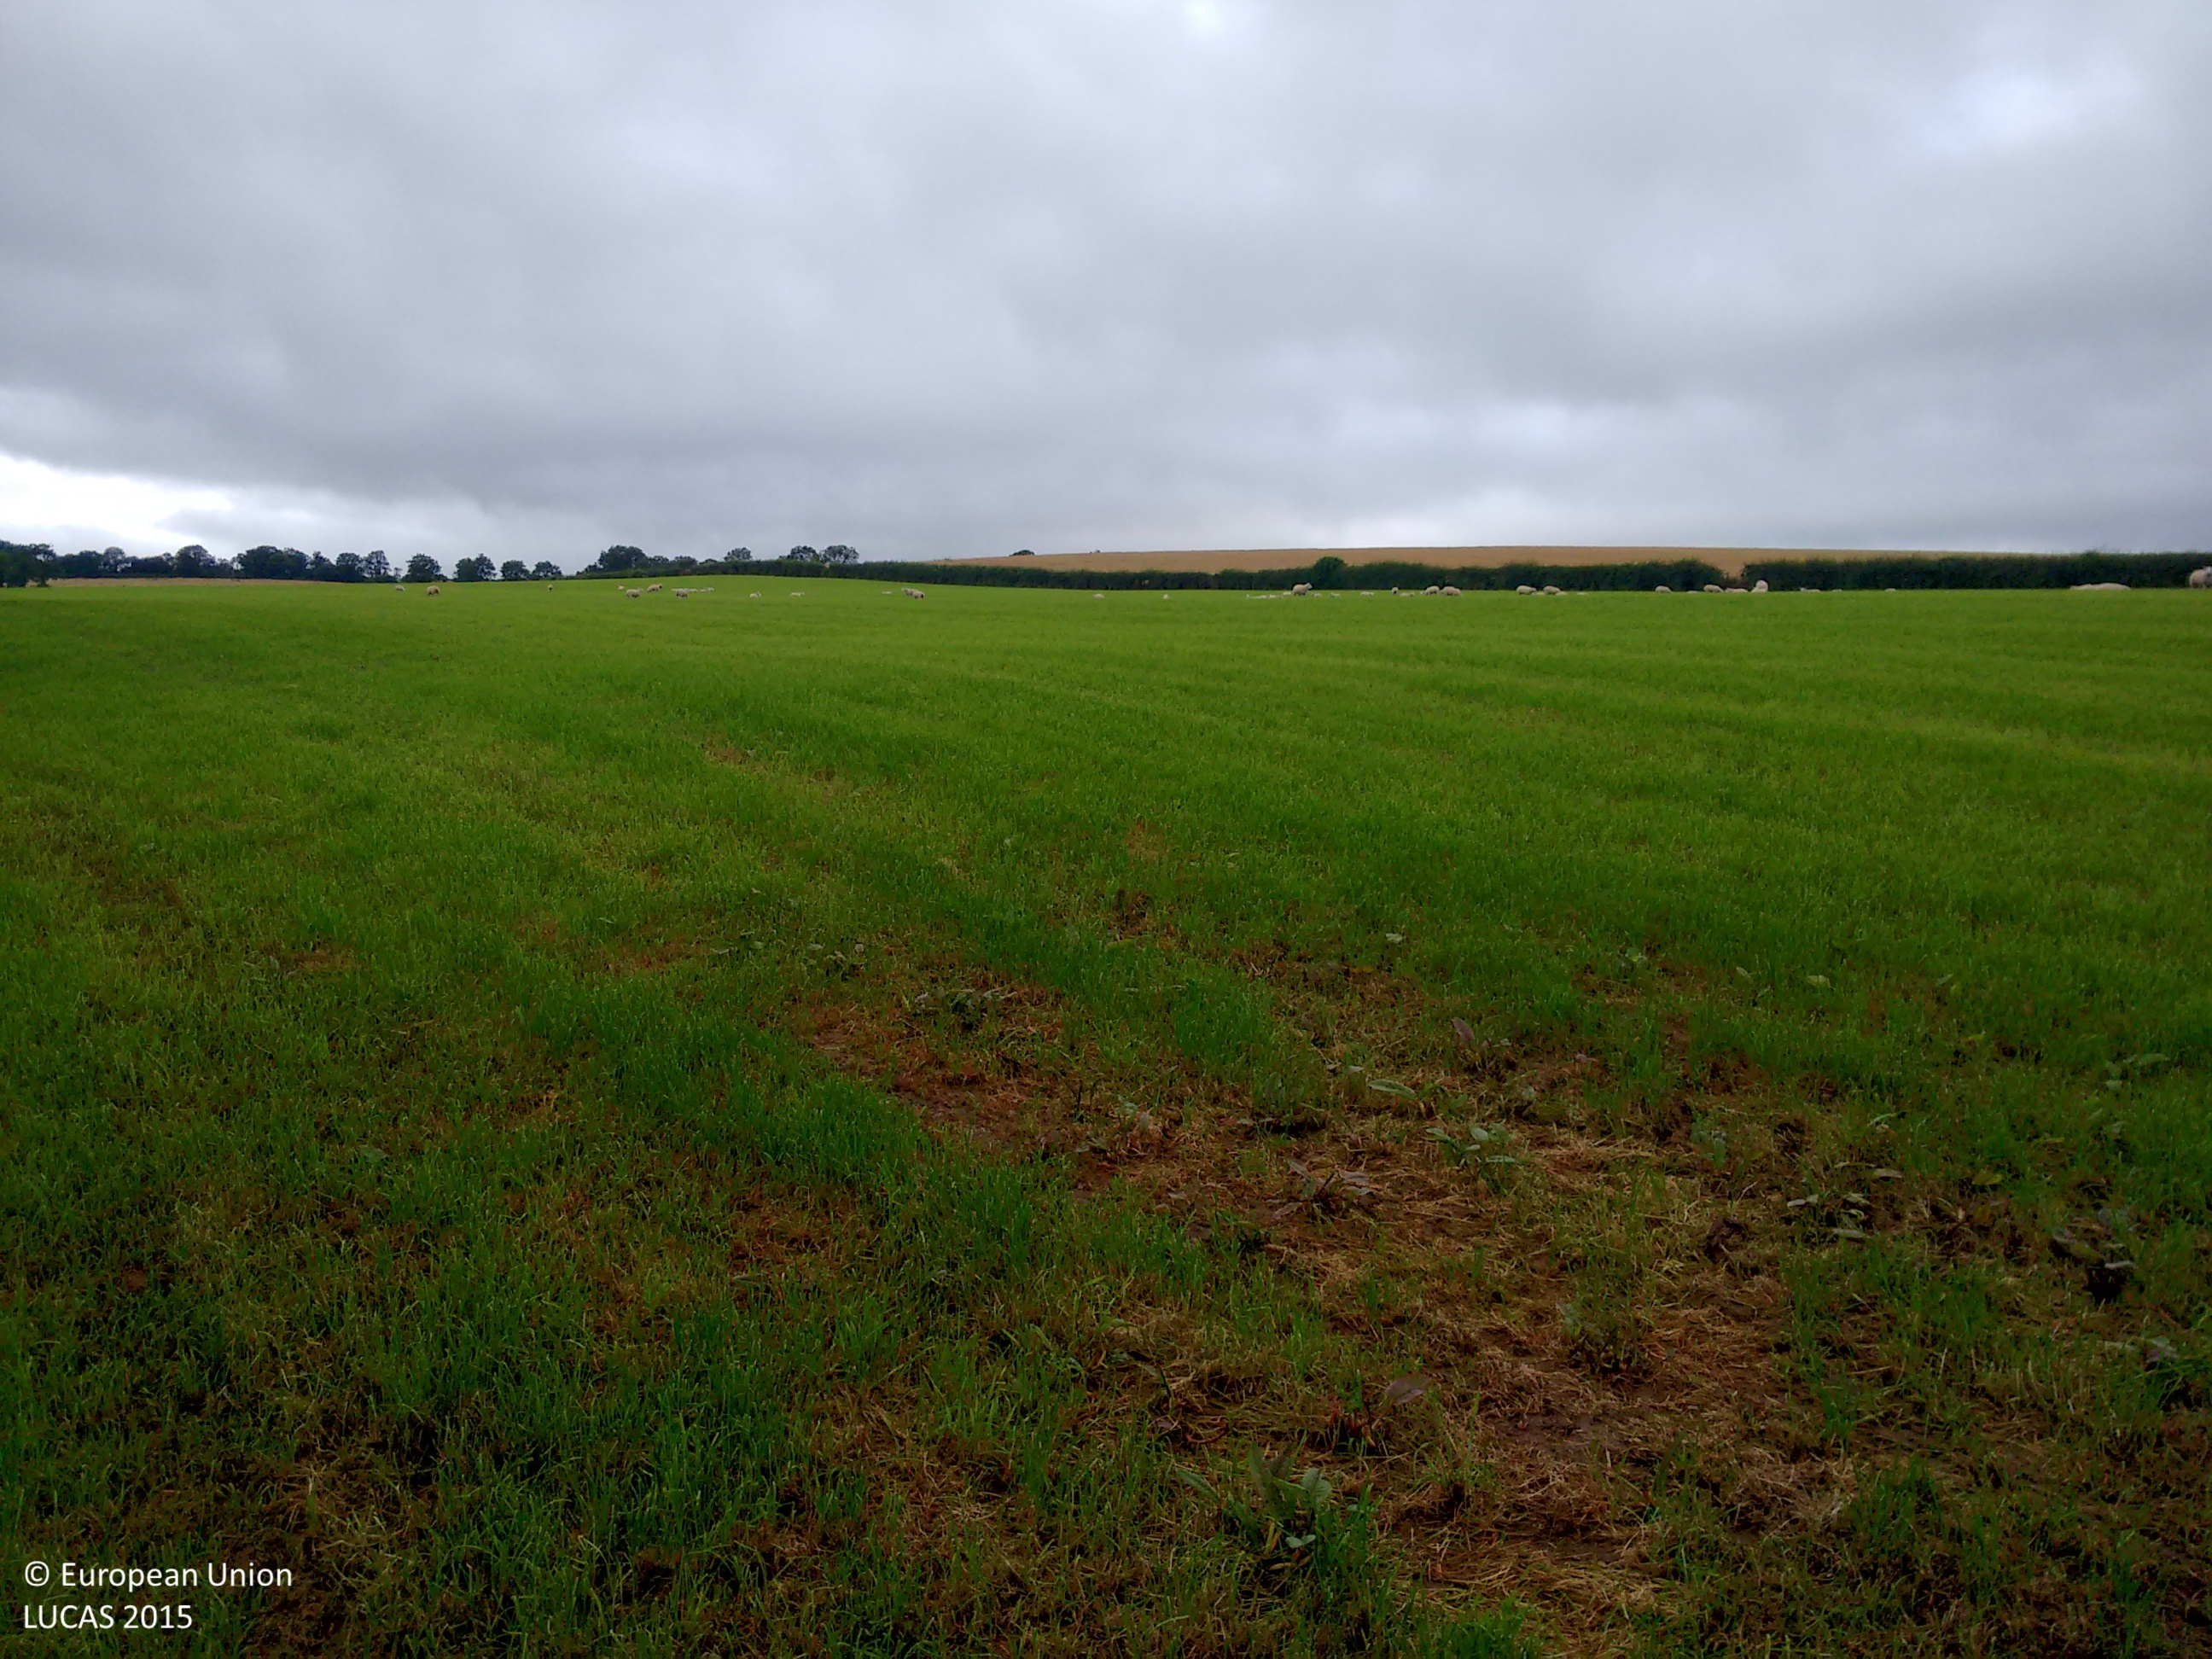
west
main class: Grassland
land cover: Grassland without tree/shrub cover
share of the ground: > 75 %
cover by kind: herbaceous plants 100 %
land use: Agriculture (excluding fallow land and kitchen gardens)
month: August
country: GB
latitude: 54.7617
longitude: -2.9545
